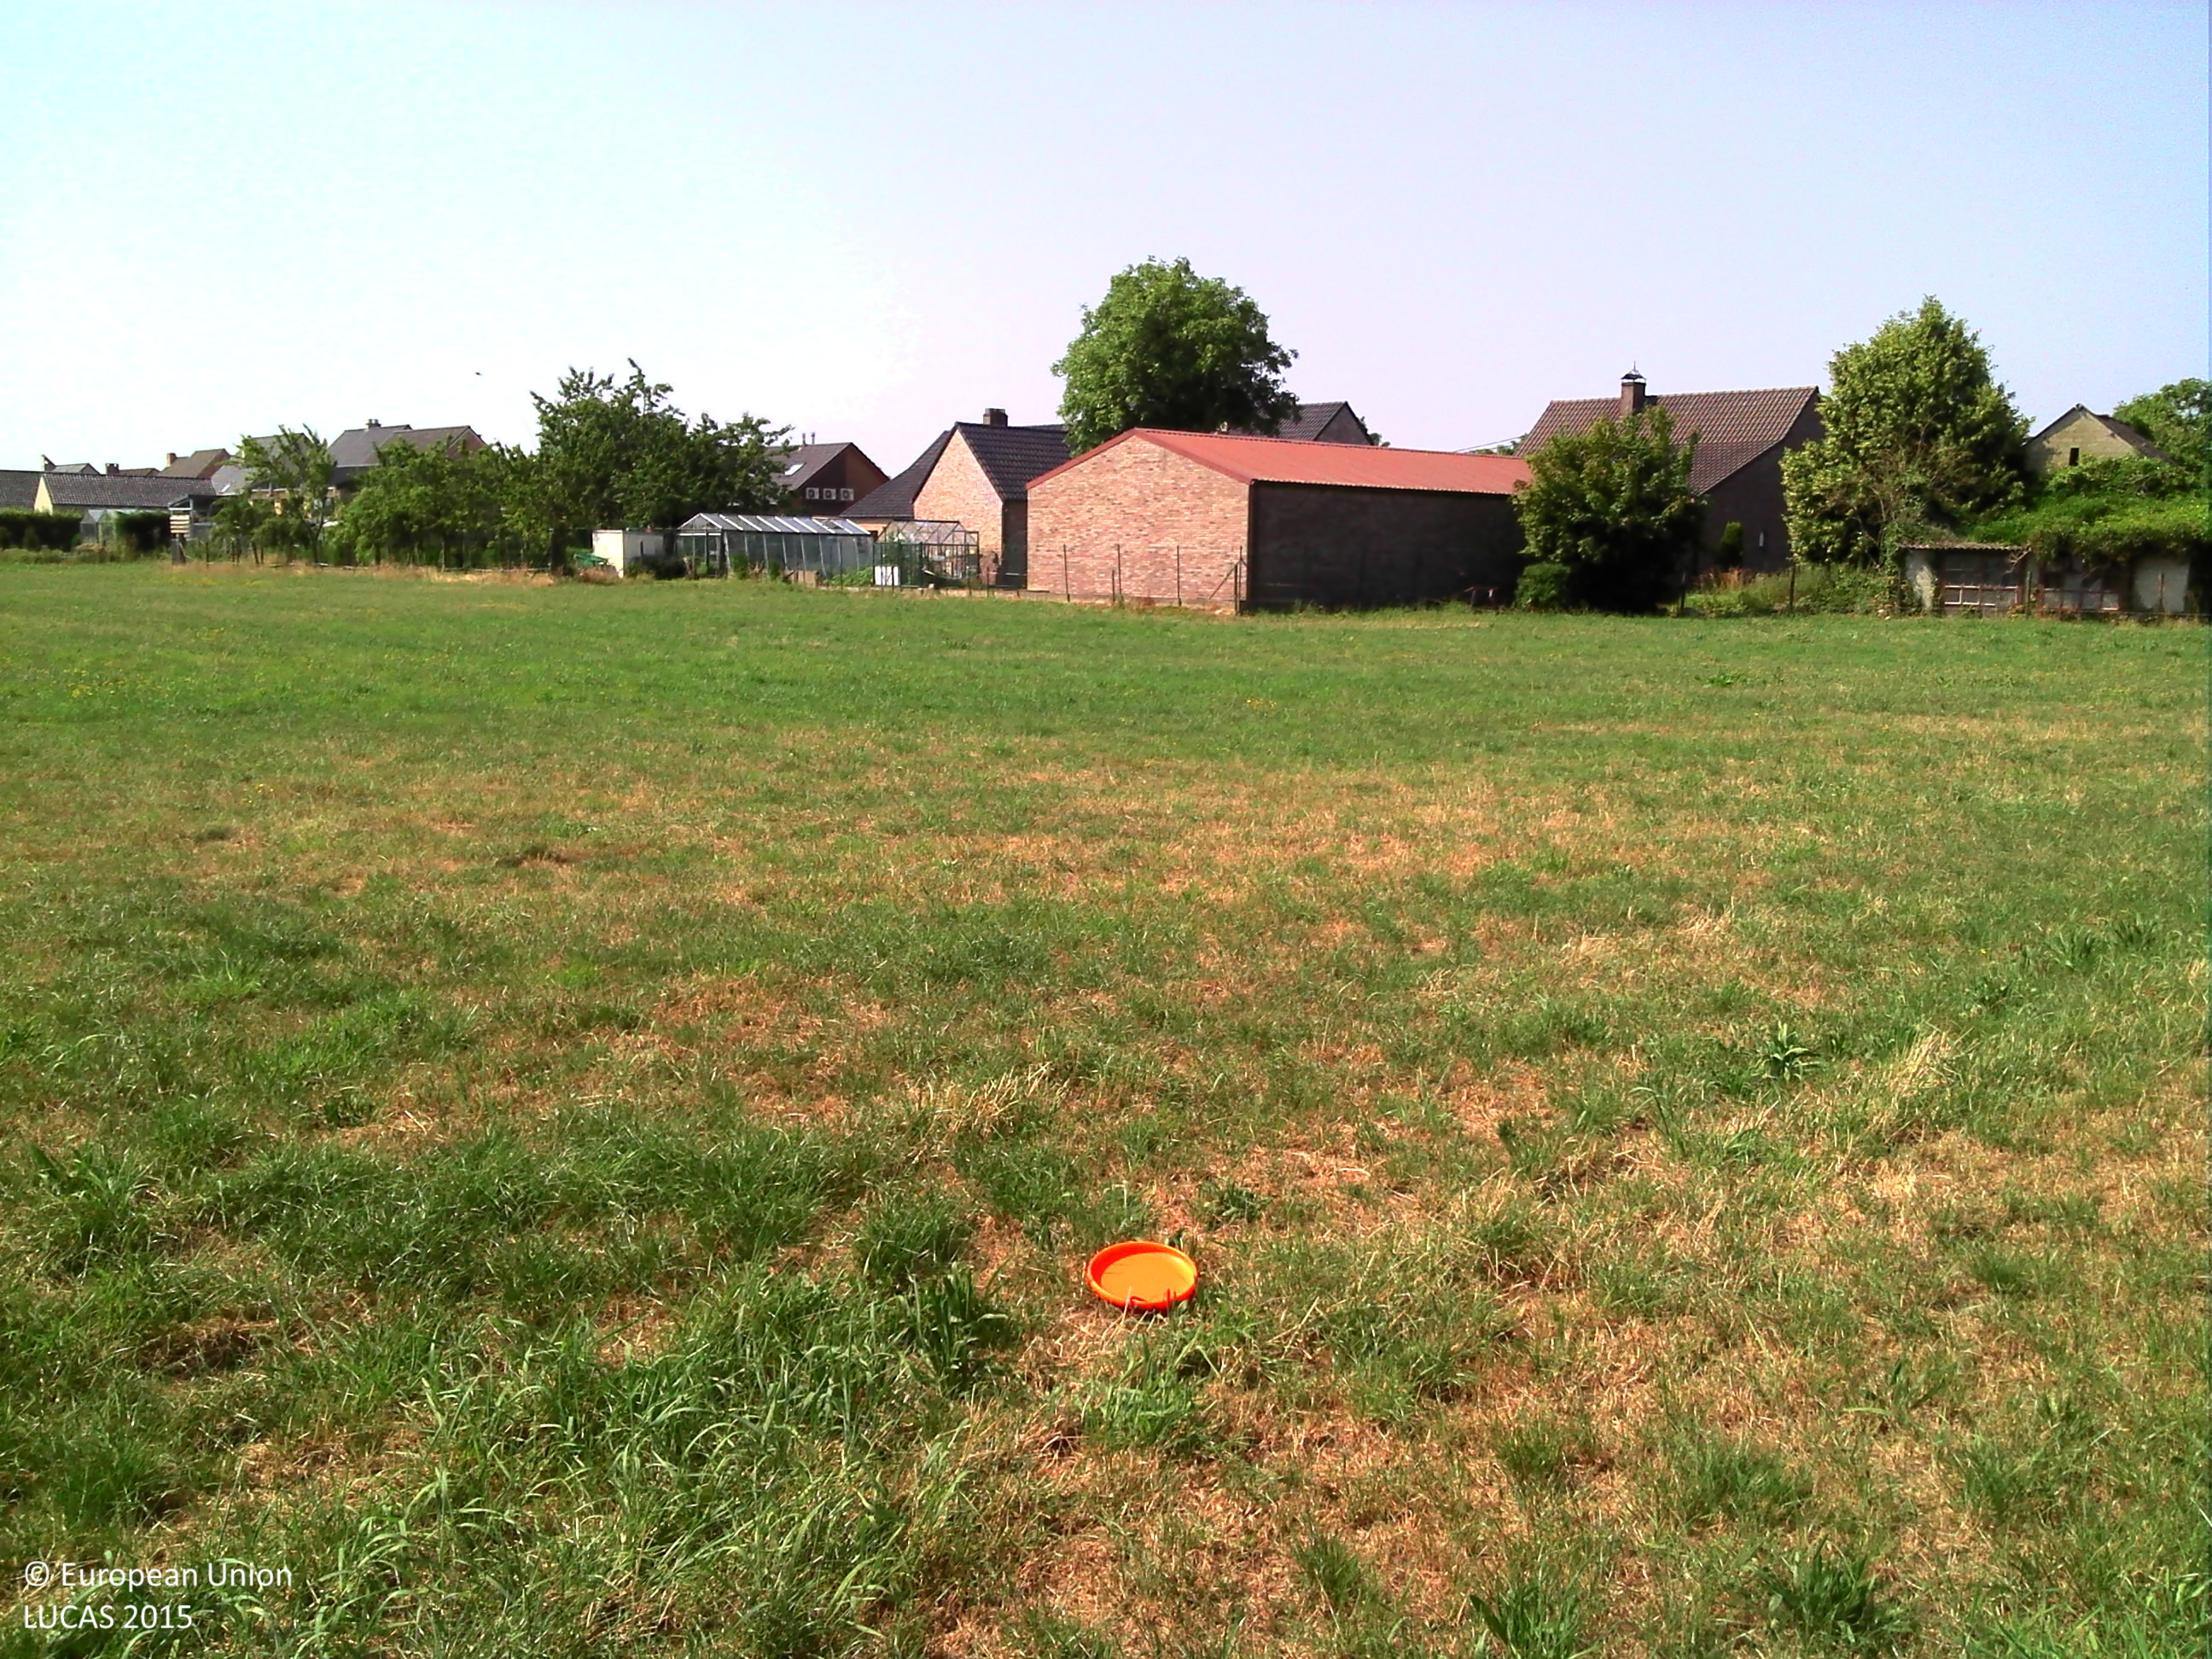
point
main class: Grassland
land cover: Grassland without tree/shrub cover
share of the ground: > 75 %
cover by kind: herbaceous plants 100 %
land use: Agriculture (excluding fallow land and kitchen gardens)
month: July
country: BE
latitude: 51.0849
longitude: 5.4727
